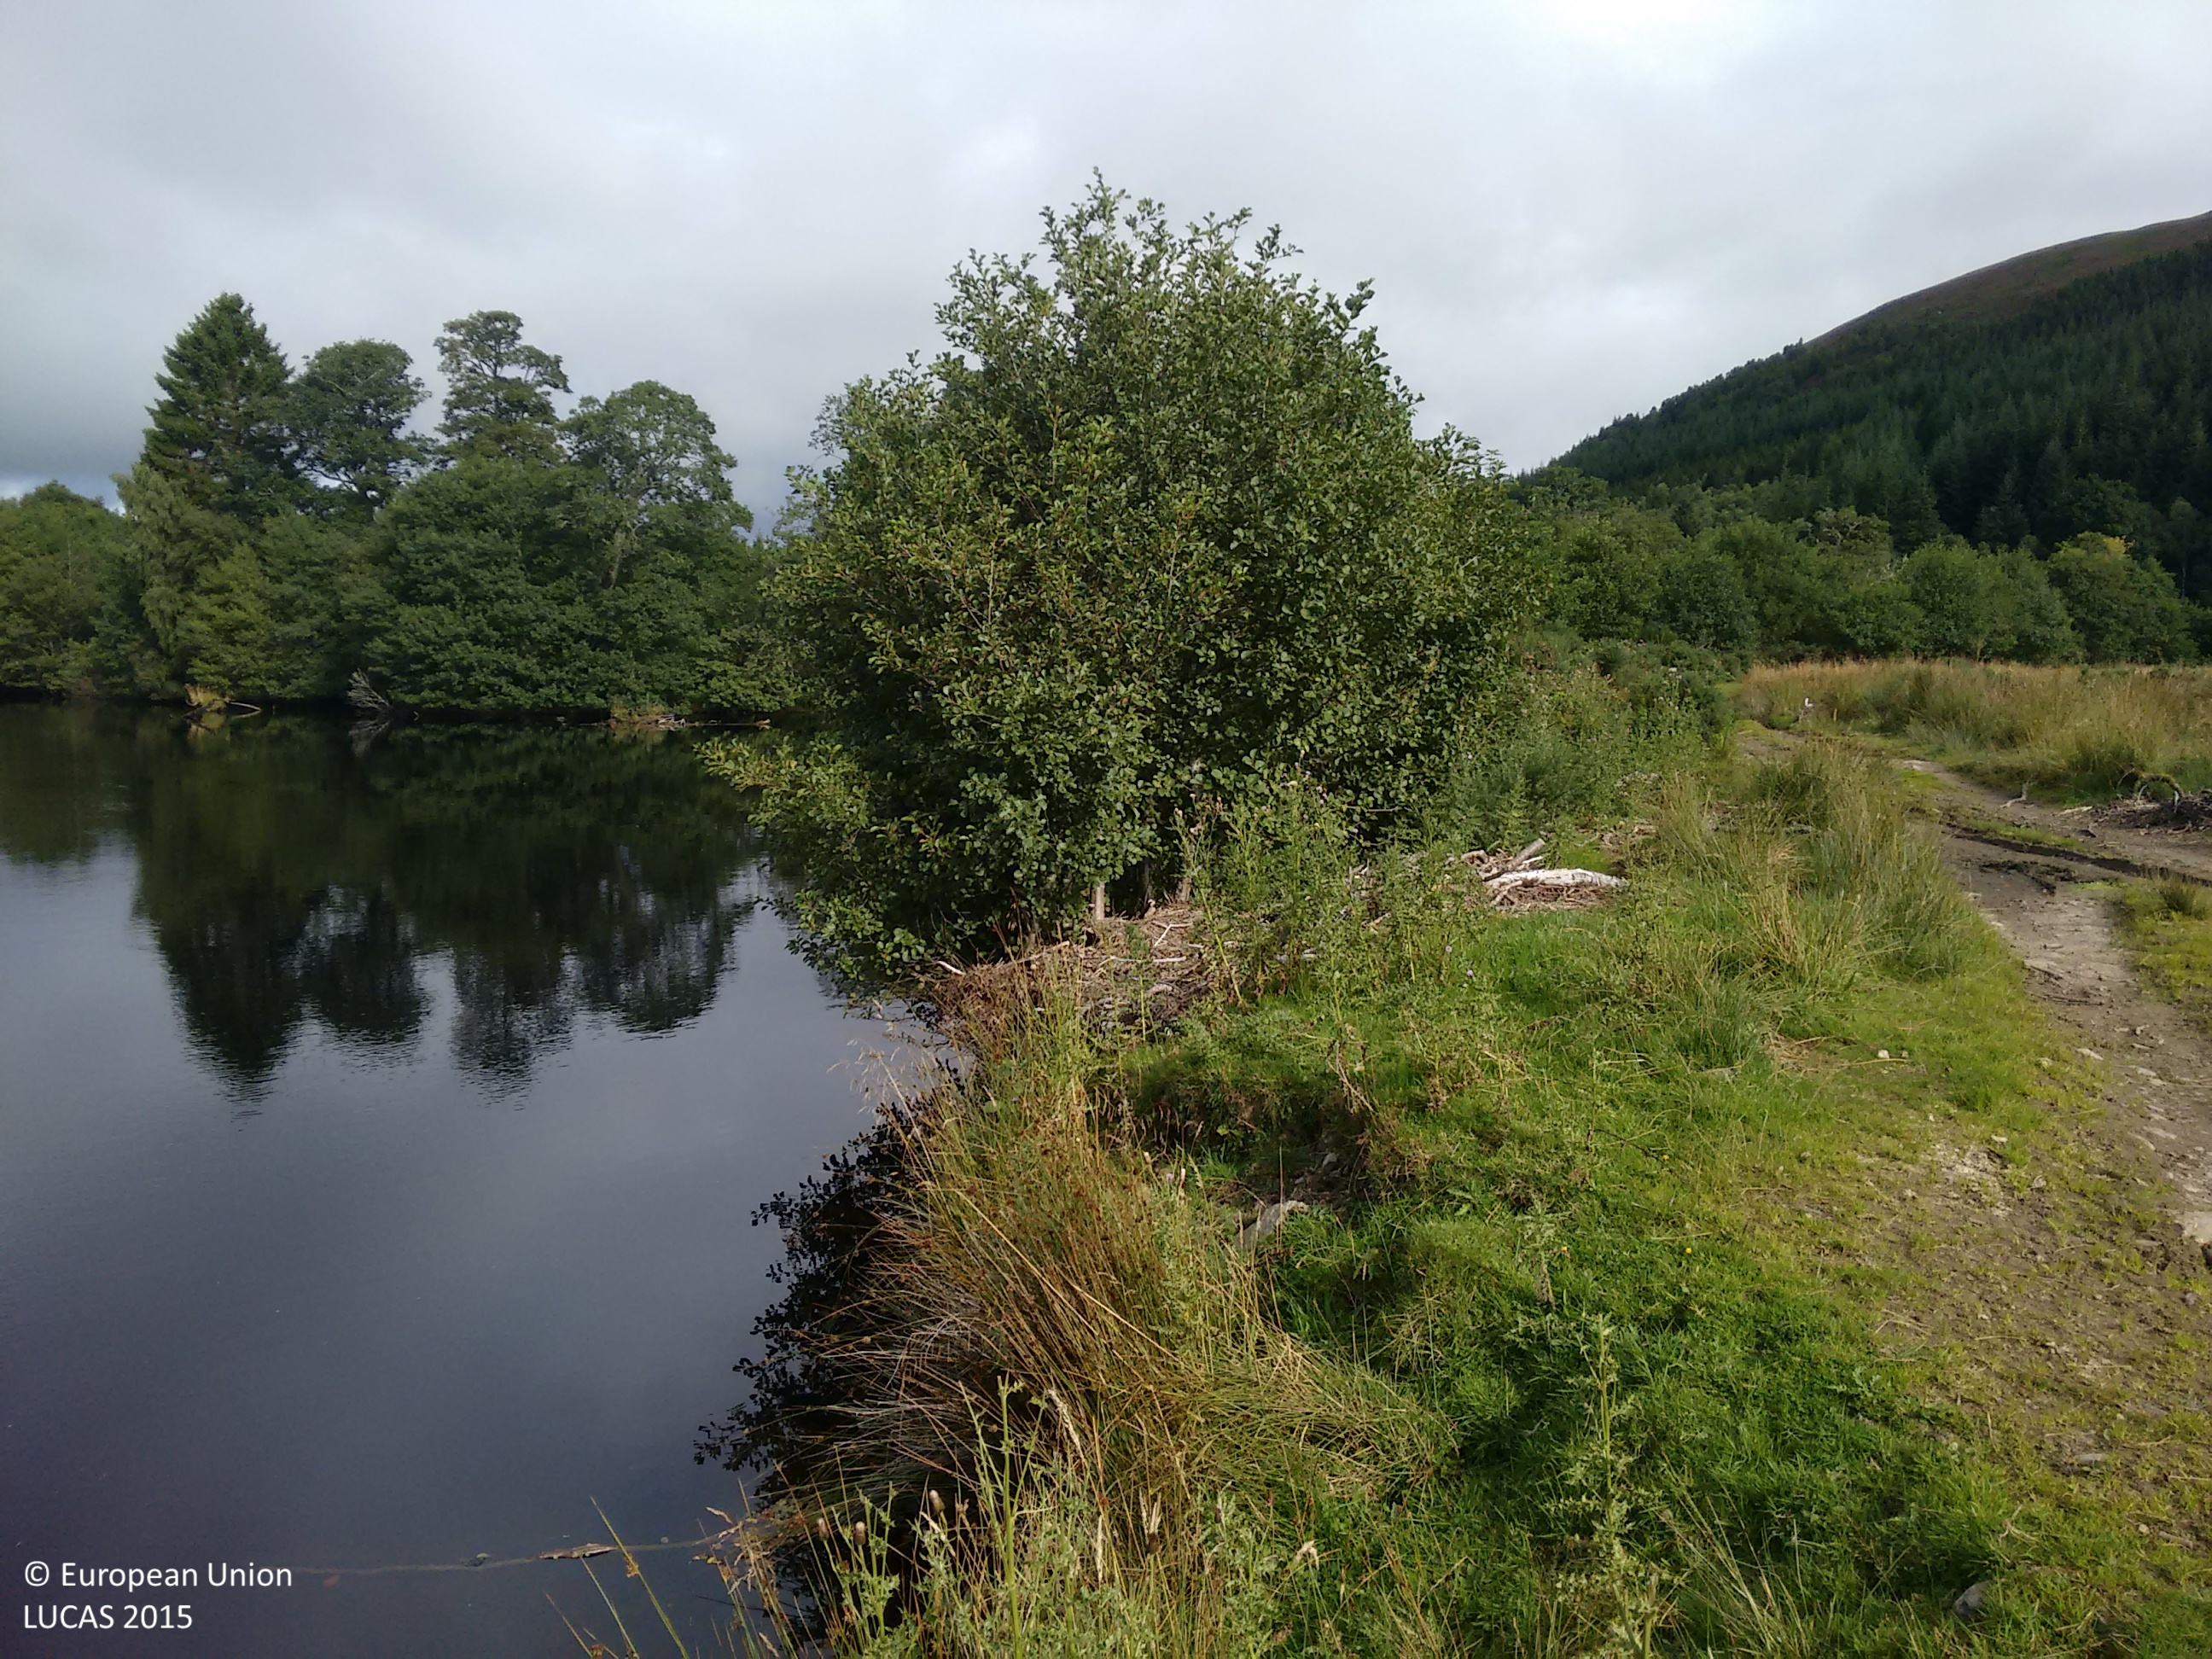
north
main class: Woodland
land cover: Broadleaved woodland
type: floodplain forest
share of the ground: > 75 %
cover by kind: broadleaved forest trees 100 %
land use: Semi-natural and natural areas not in use
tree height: > 5 m
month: September
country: GB
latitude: 57.6095
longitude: -4.6726
